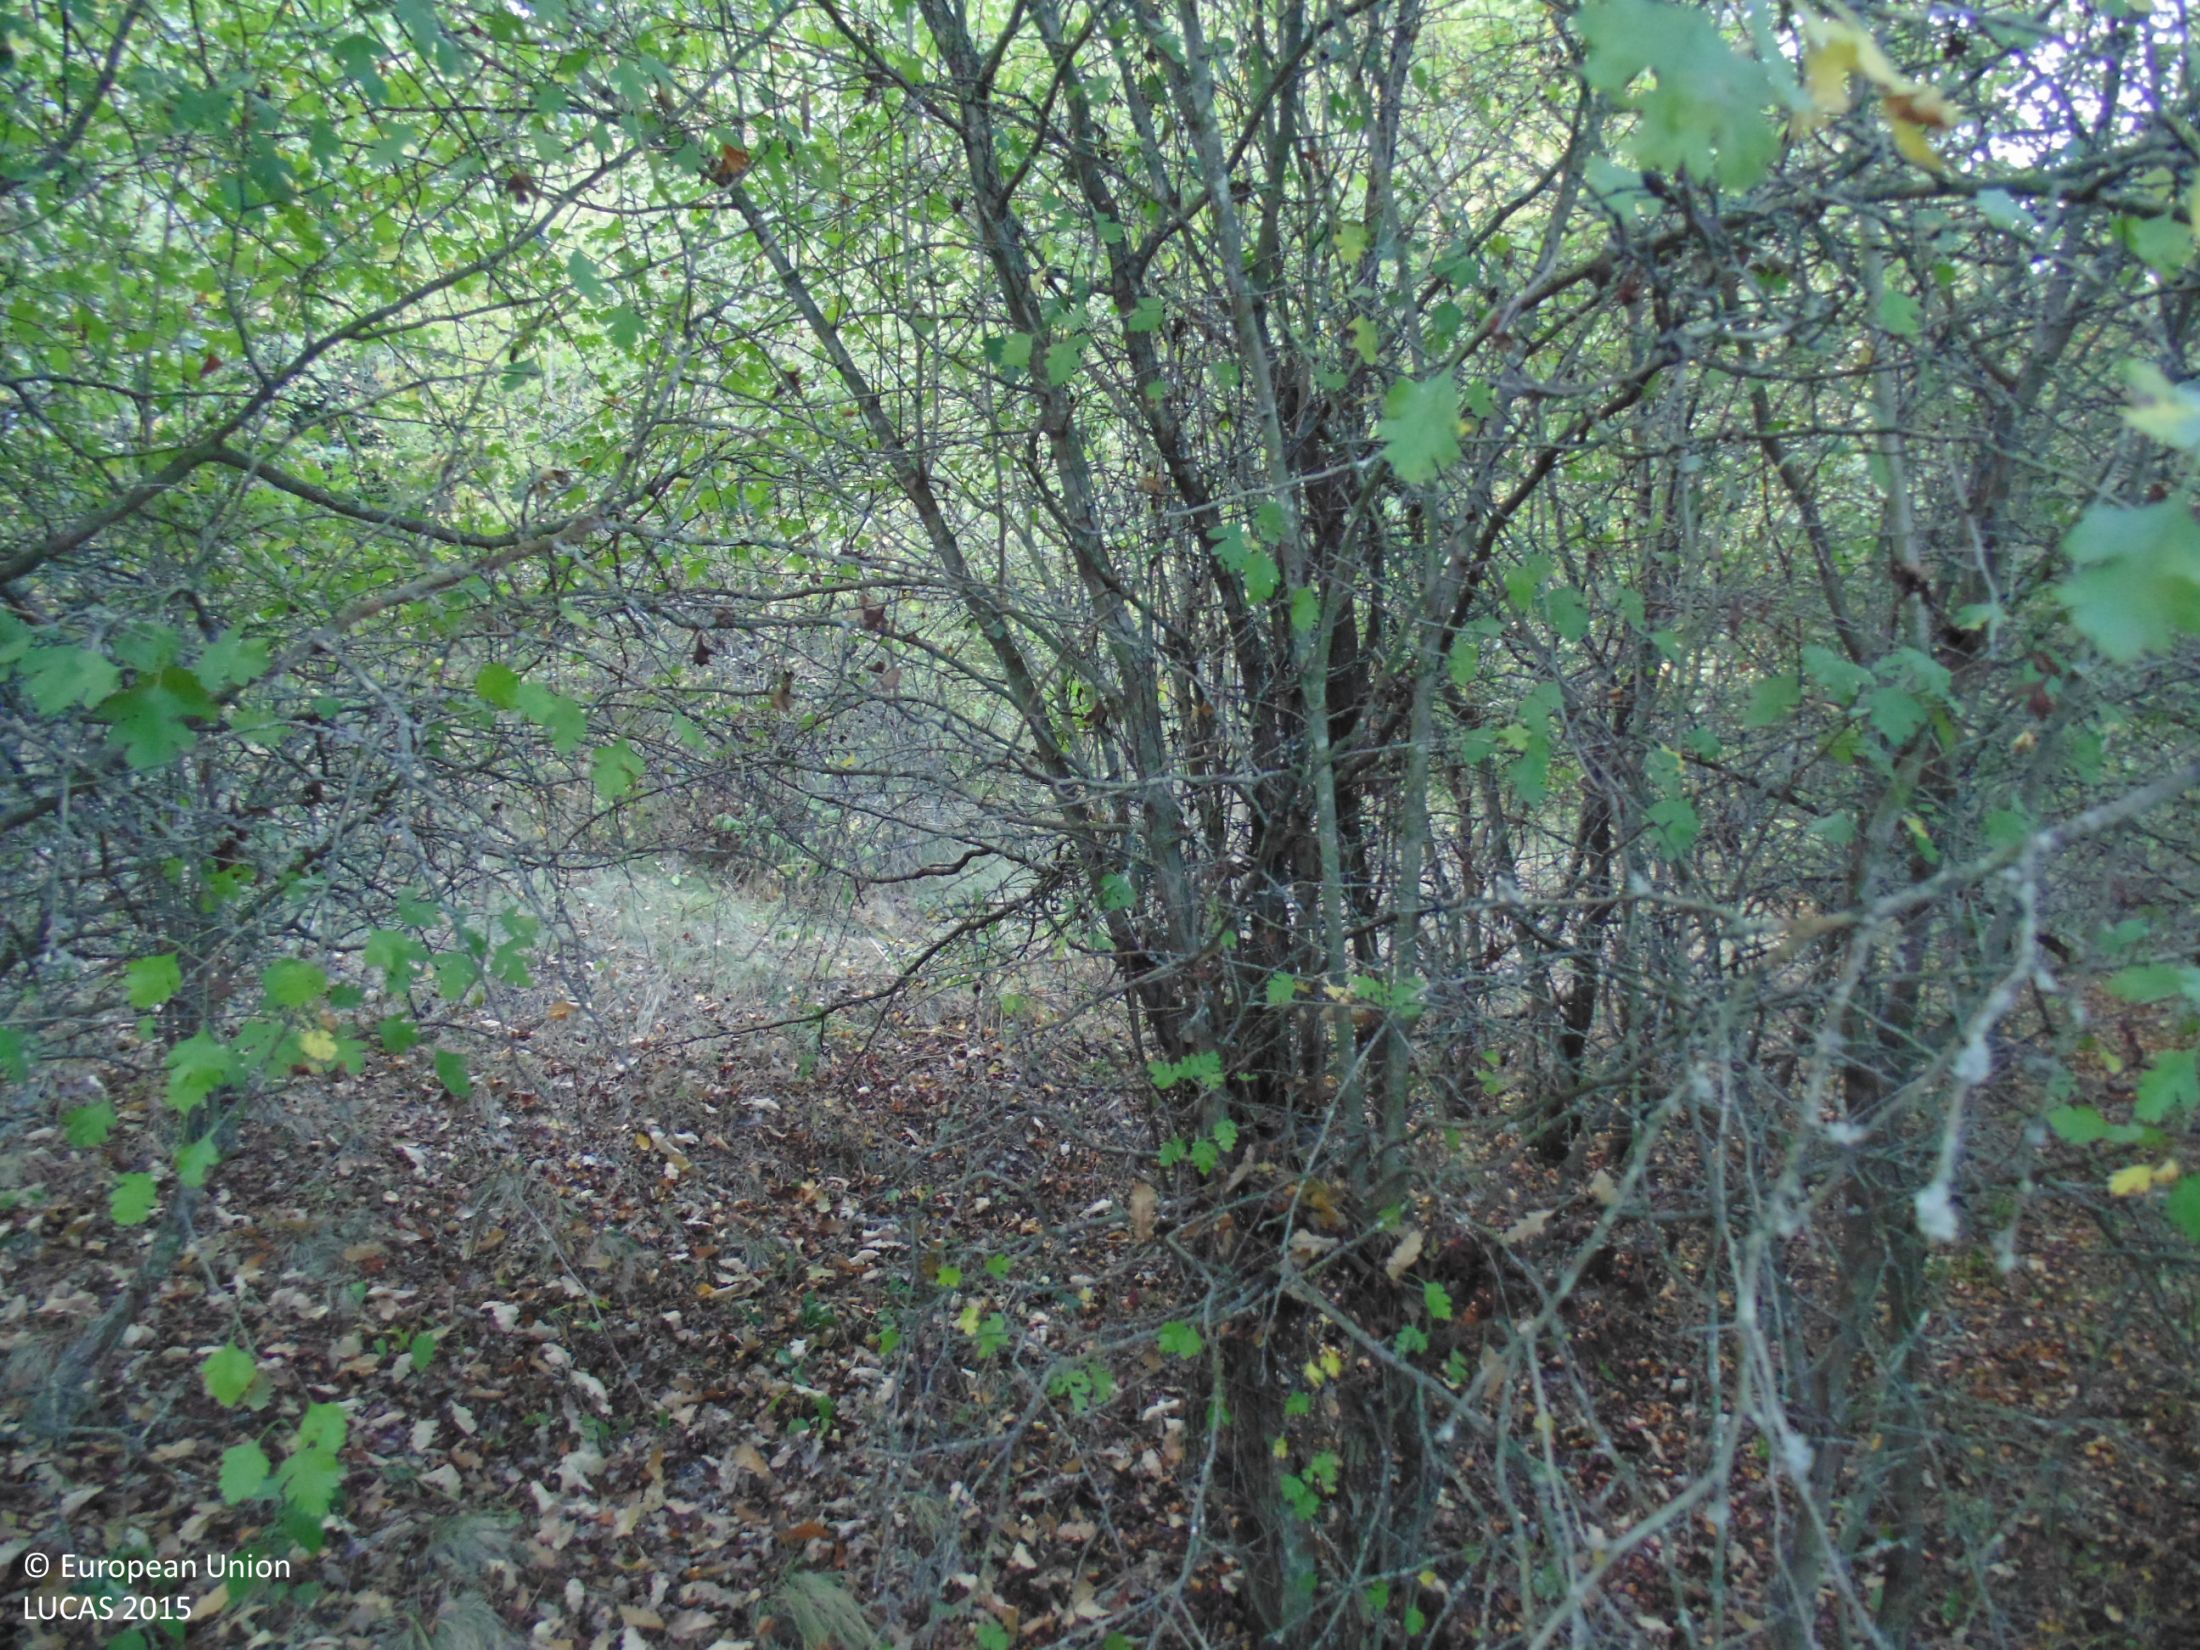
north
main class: Woodland
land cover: Broadleaved woodland
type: mesophytic deciduous forest
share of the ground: > 75 %
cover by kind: broadleaved forest trees 90 %, shrubs 10 %
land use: Forestry
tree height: > 5 m
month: September
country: BG
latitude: 43.8827
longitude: 27.1655
